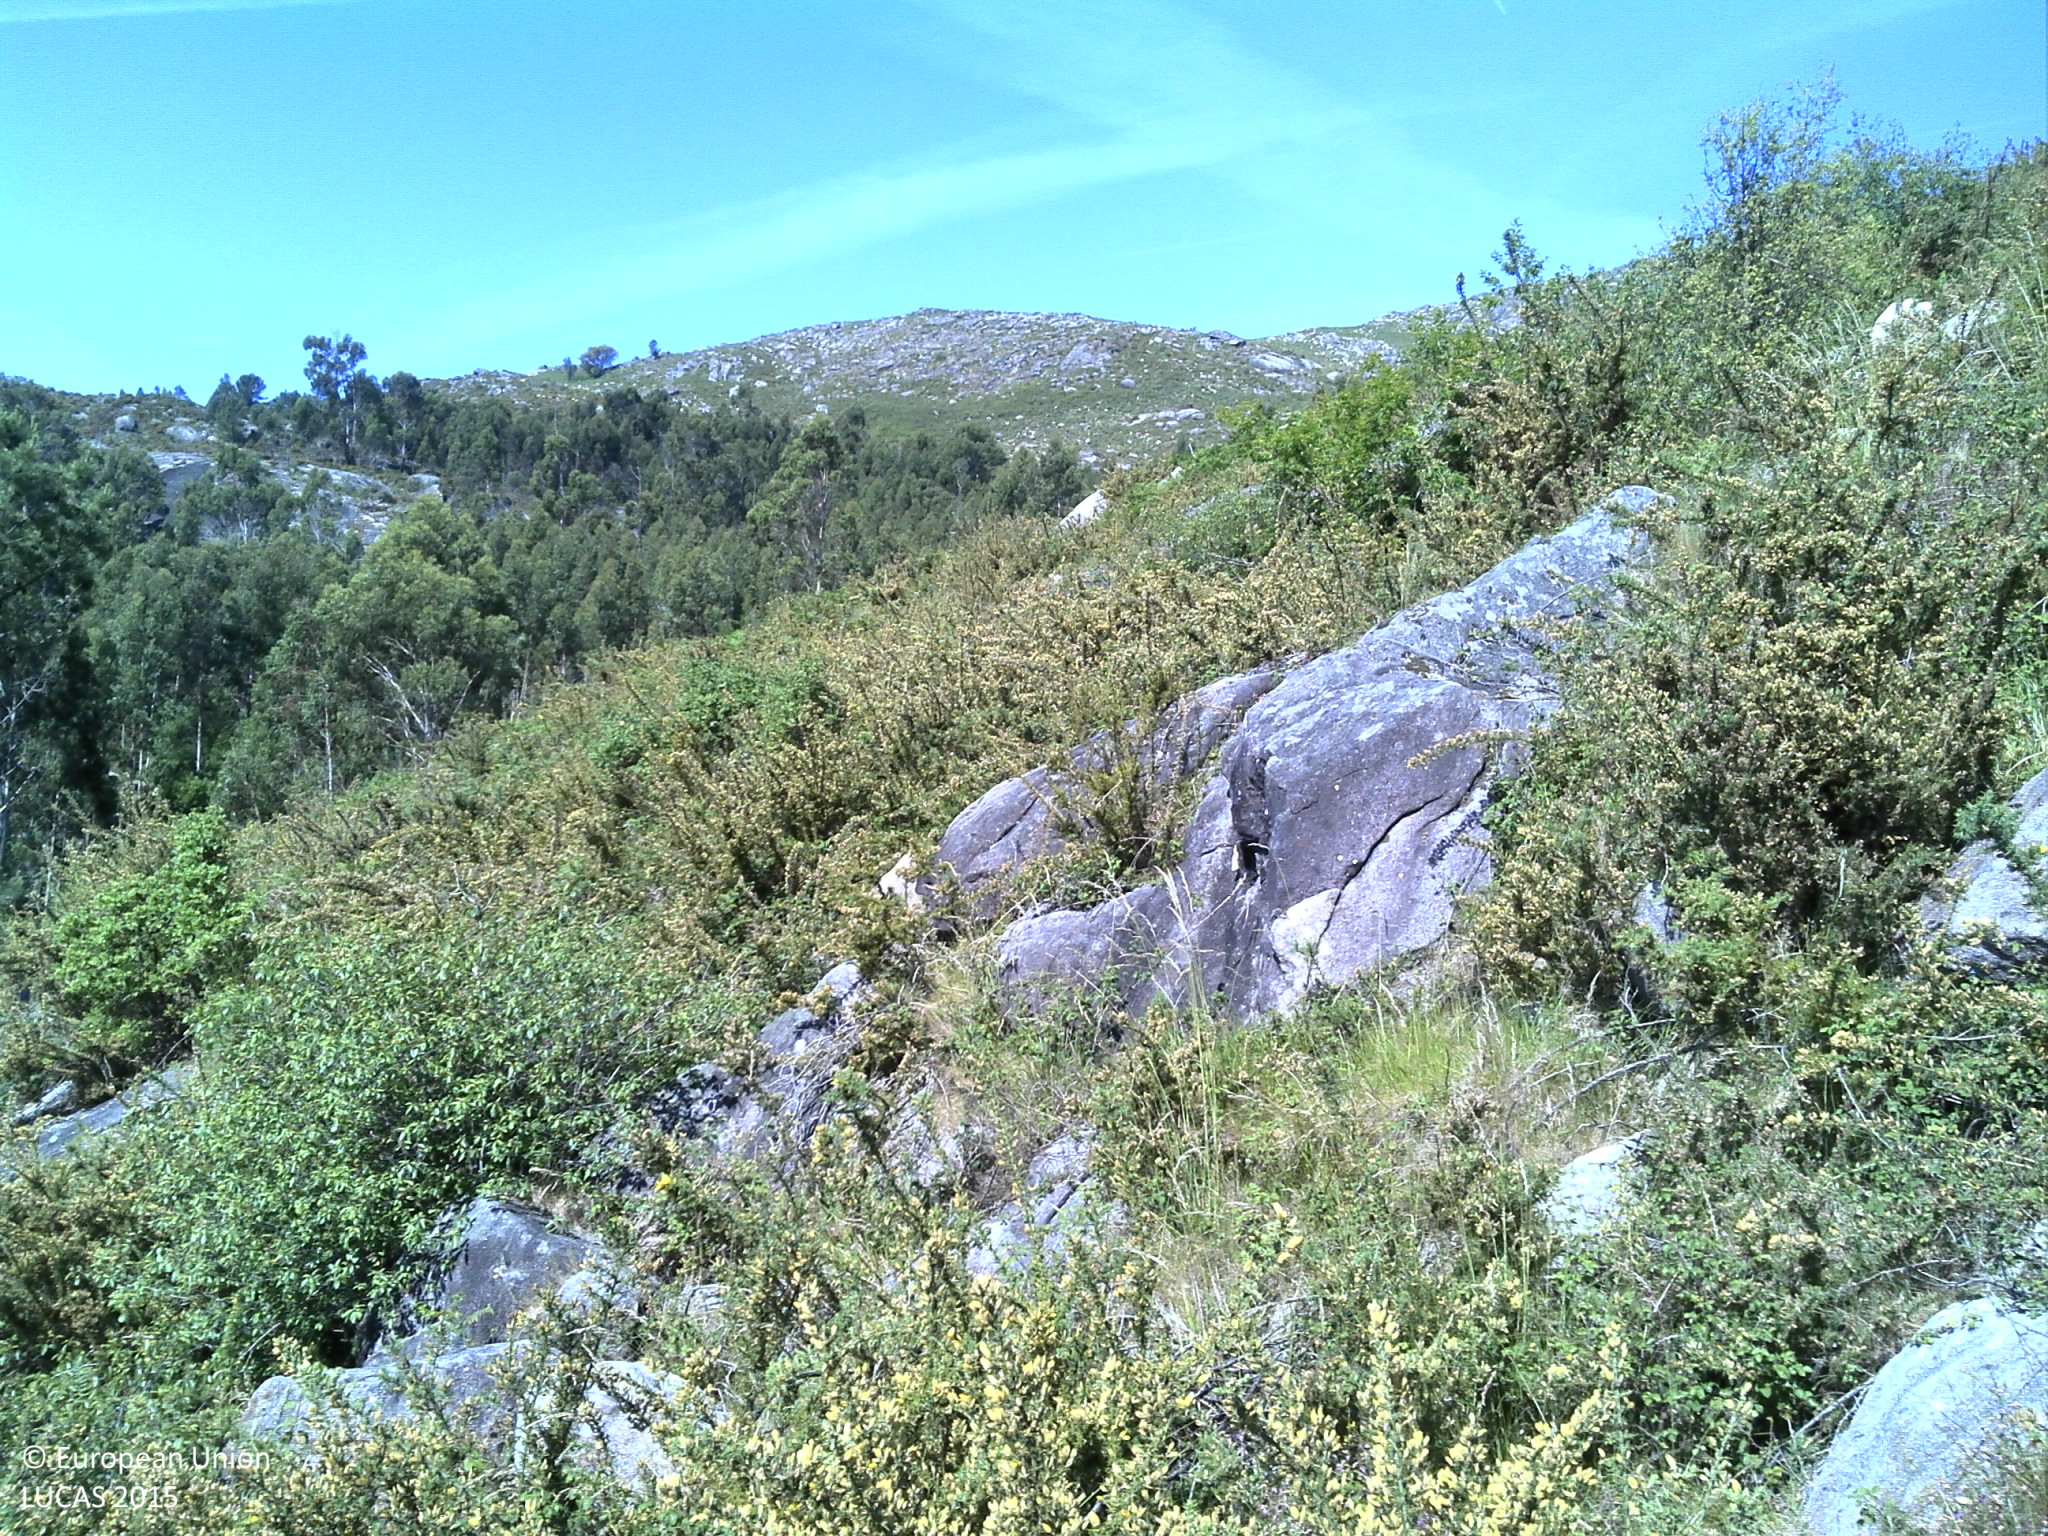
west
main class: Shrubland
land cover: Shrubland without tree cover
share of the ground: > 75 %
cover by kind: shrubs 80 %, unconsolidated bare surface 20 %
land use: Semi-natural and natural areas not in use
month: May
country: PT
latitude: 41.7623
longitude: -8.8003
